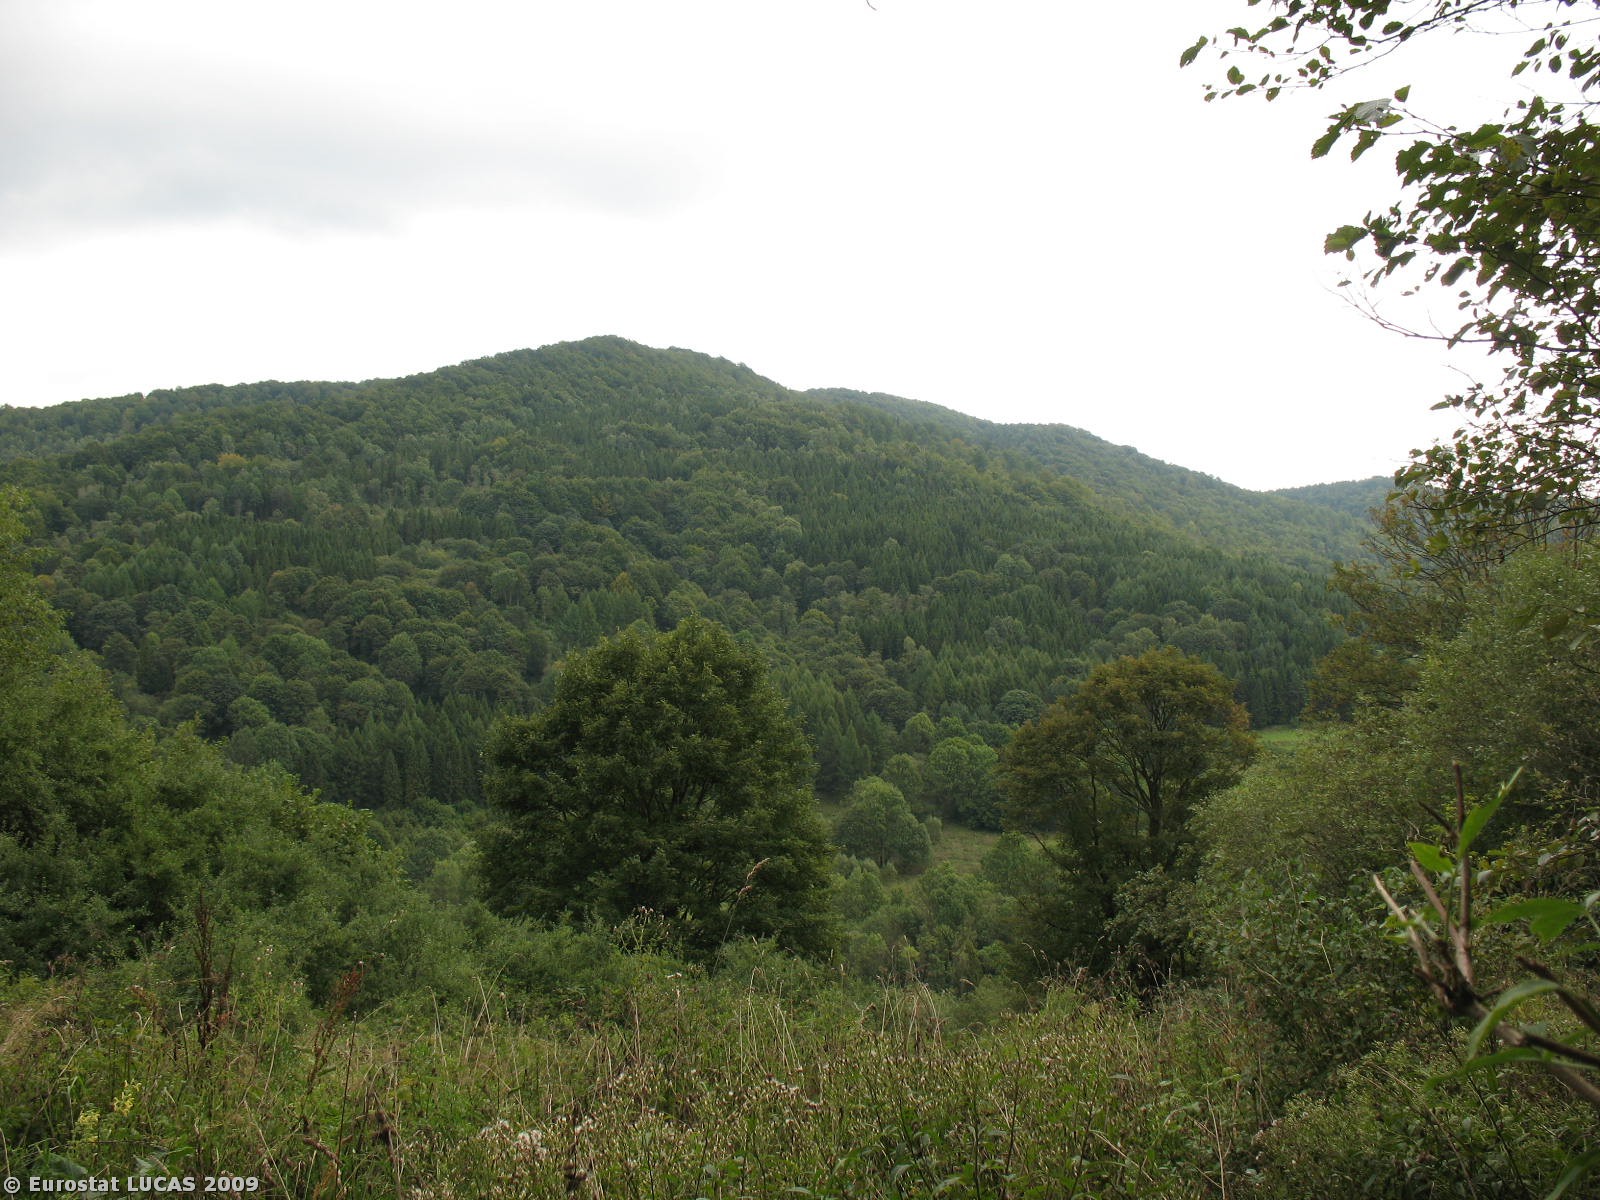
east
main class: Woodland
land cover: Broadleaved woodland
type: mesophytic deciduous forest
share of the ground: > 75 %
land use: Nature reserves
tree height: > 5 m
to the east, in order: Broadleaved woodland
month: September
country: PL
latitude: 49.2273
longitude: 22.4349
